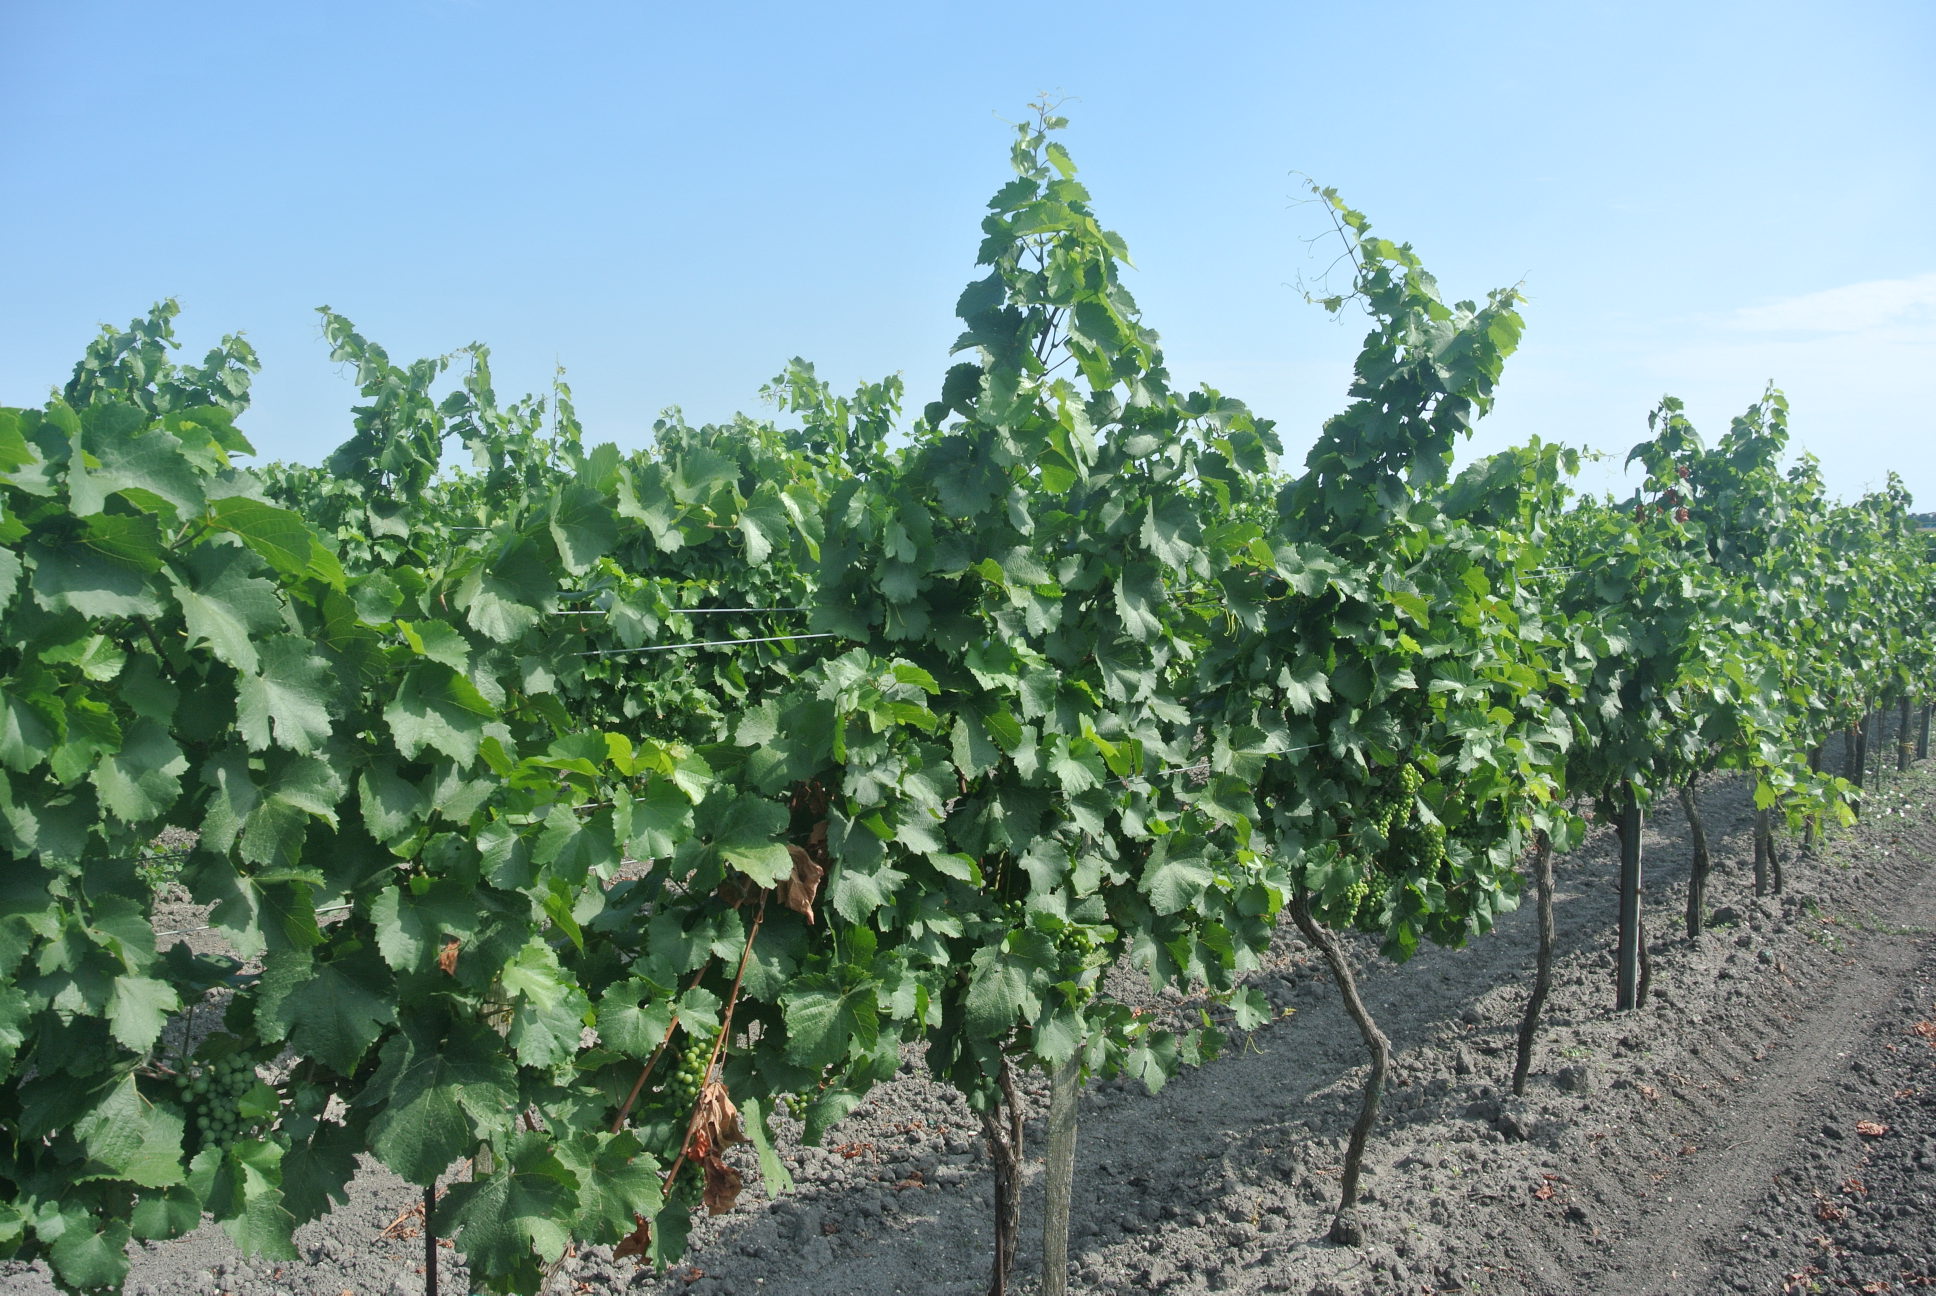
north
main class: Cropland
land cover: Vineyards
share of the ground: 25 - 50 %
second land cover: Other bare soil
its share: > 75 %
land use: Agriculture (excluding fallow land and kitchen gardens)
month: July
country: AT
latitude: 47.7234
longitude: 16.8181
